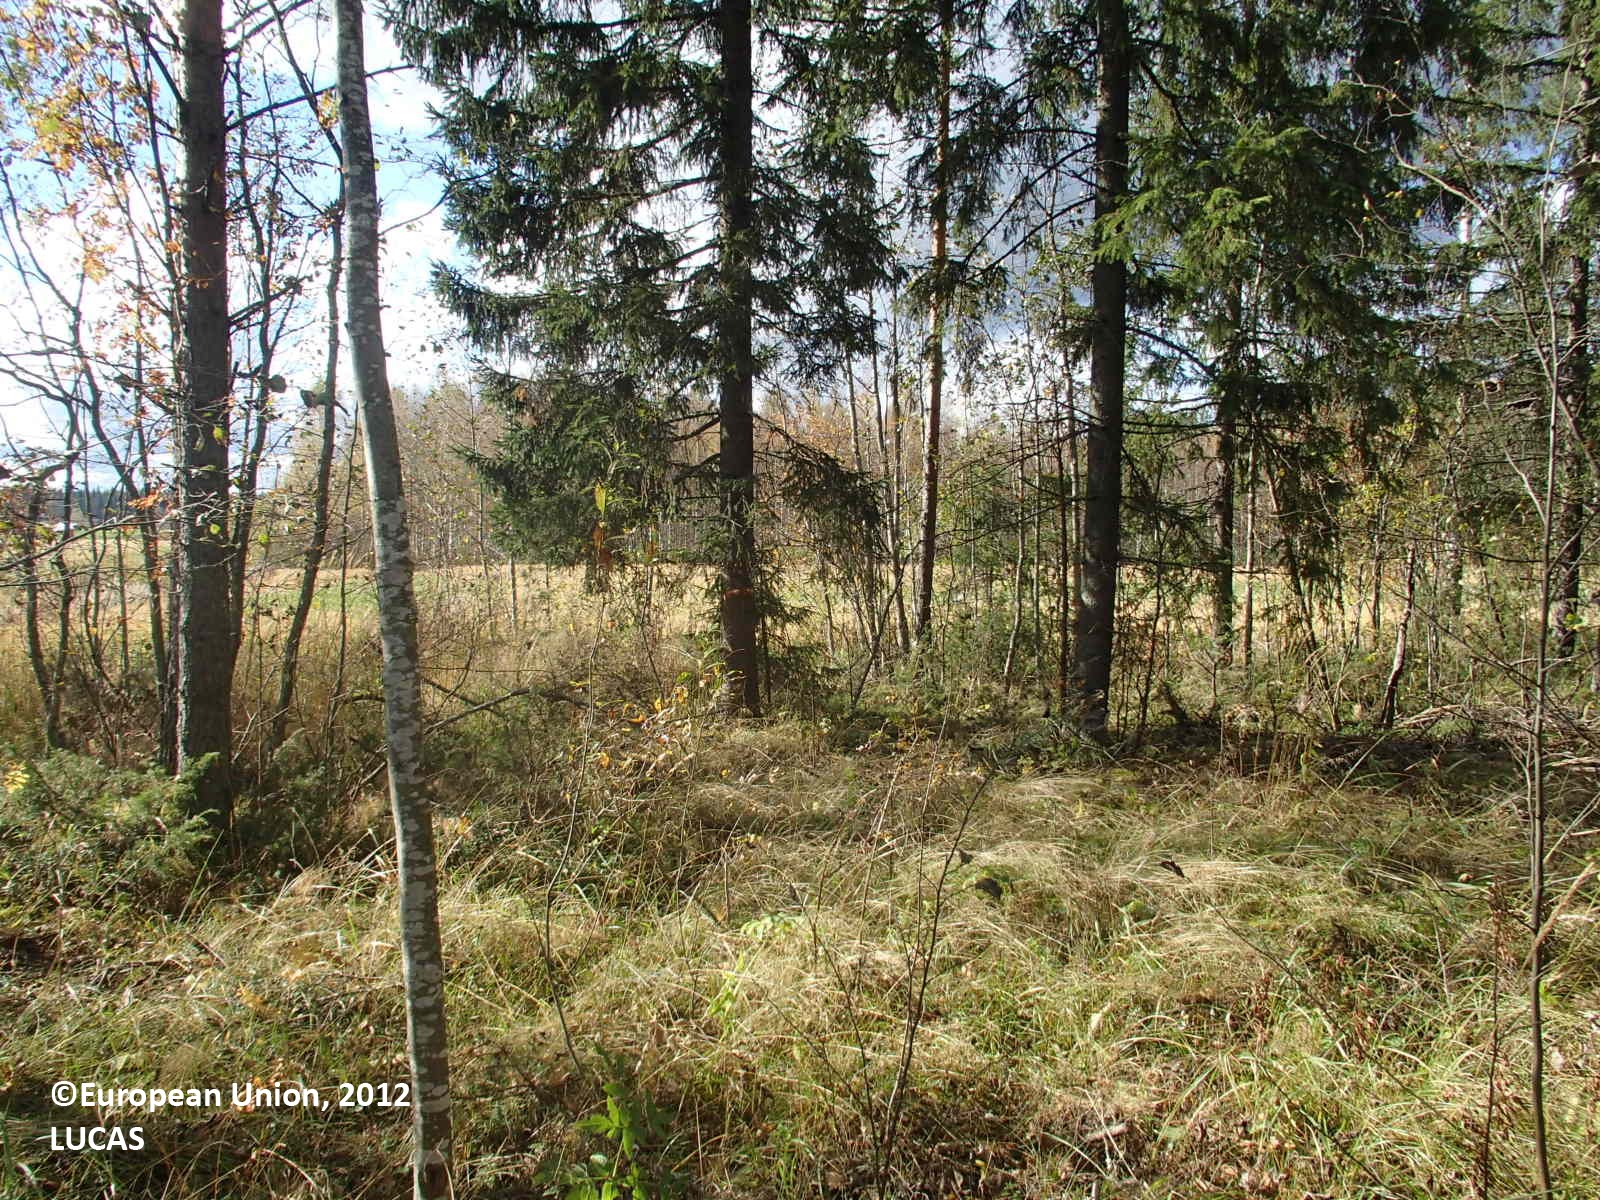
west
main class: Woodland
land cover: Spruce dominated mixed woodland
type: boreal forest
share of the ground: > 75 %
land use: Forestry
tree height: > 5 m
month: September
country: FI
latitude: 63.6200
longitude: 26.6506
